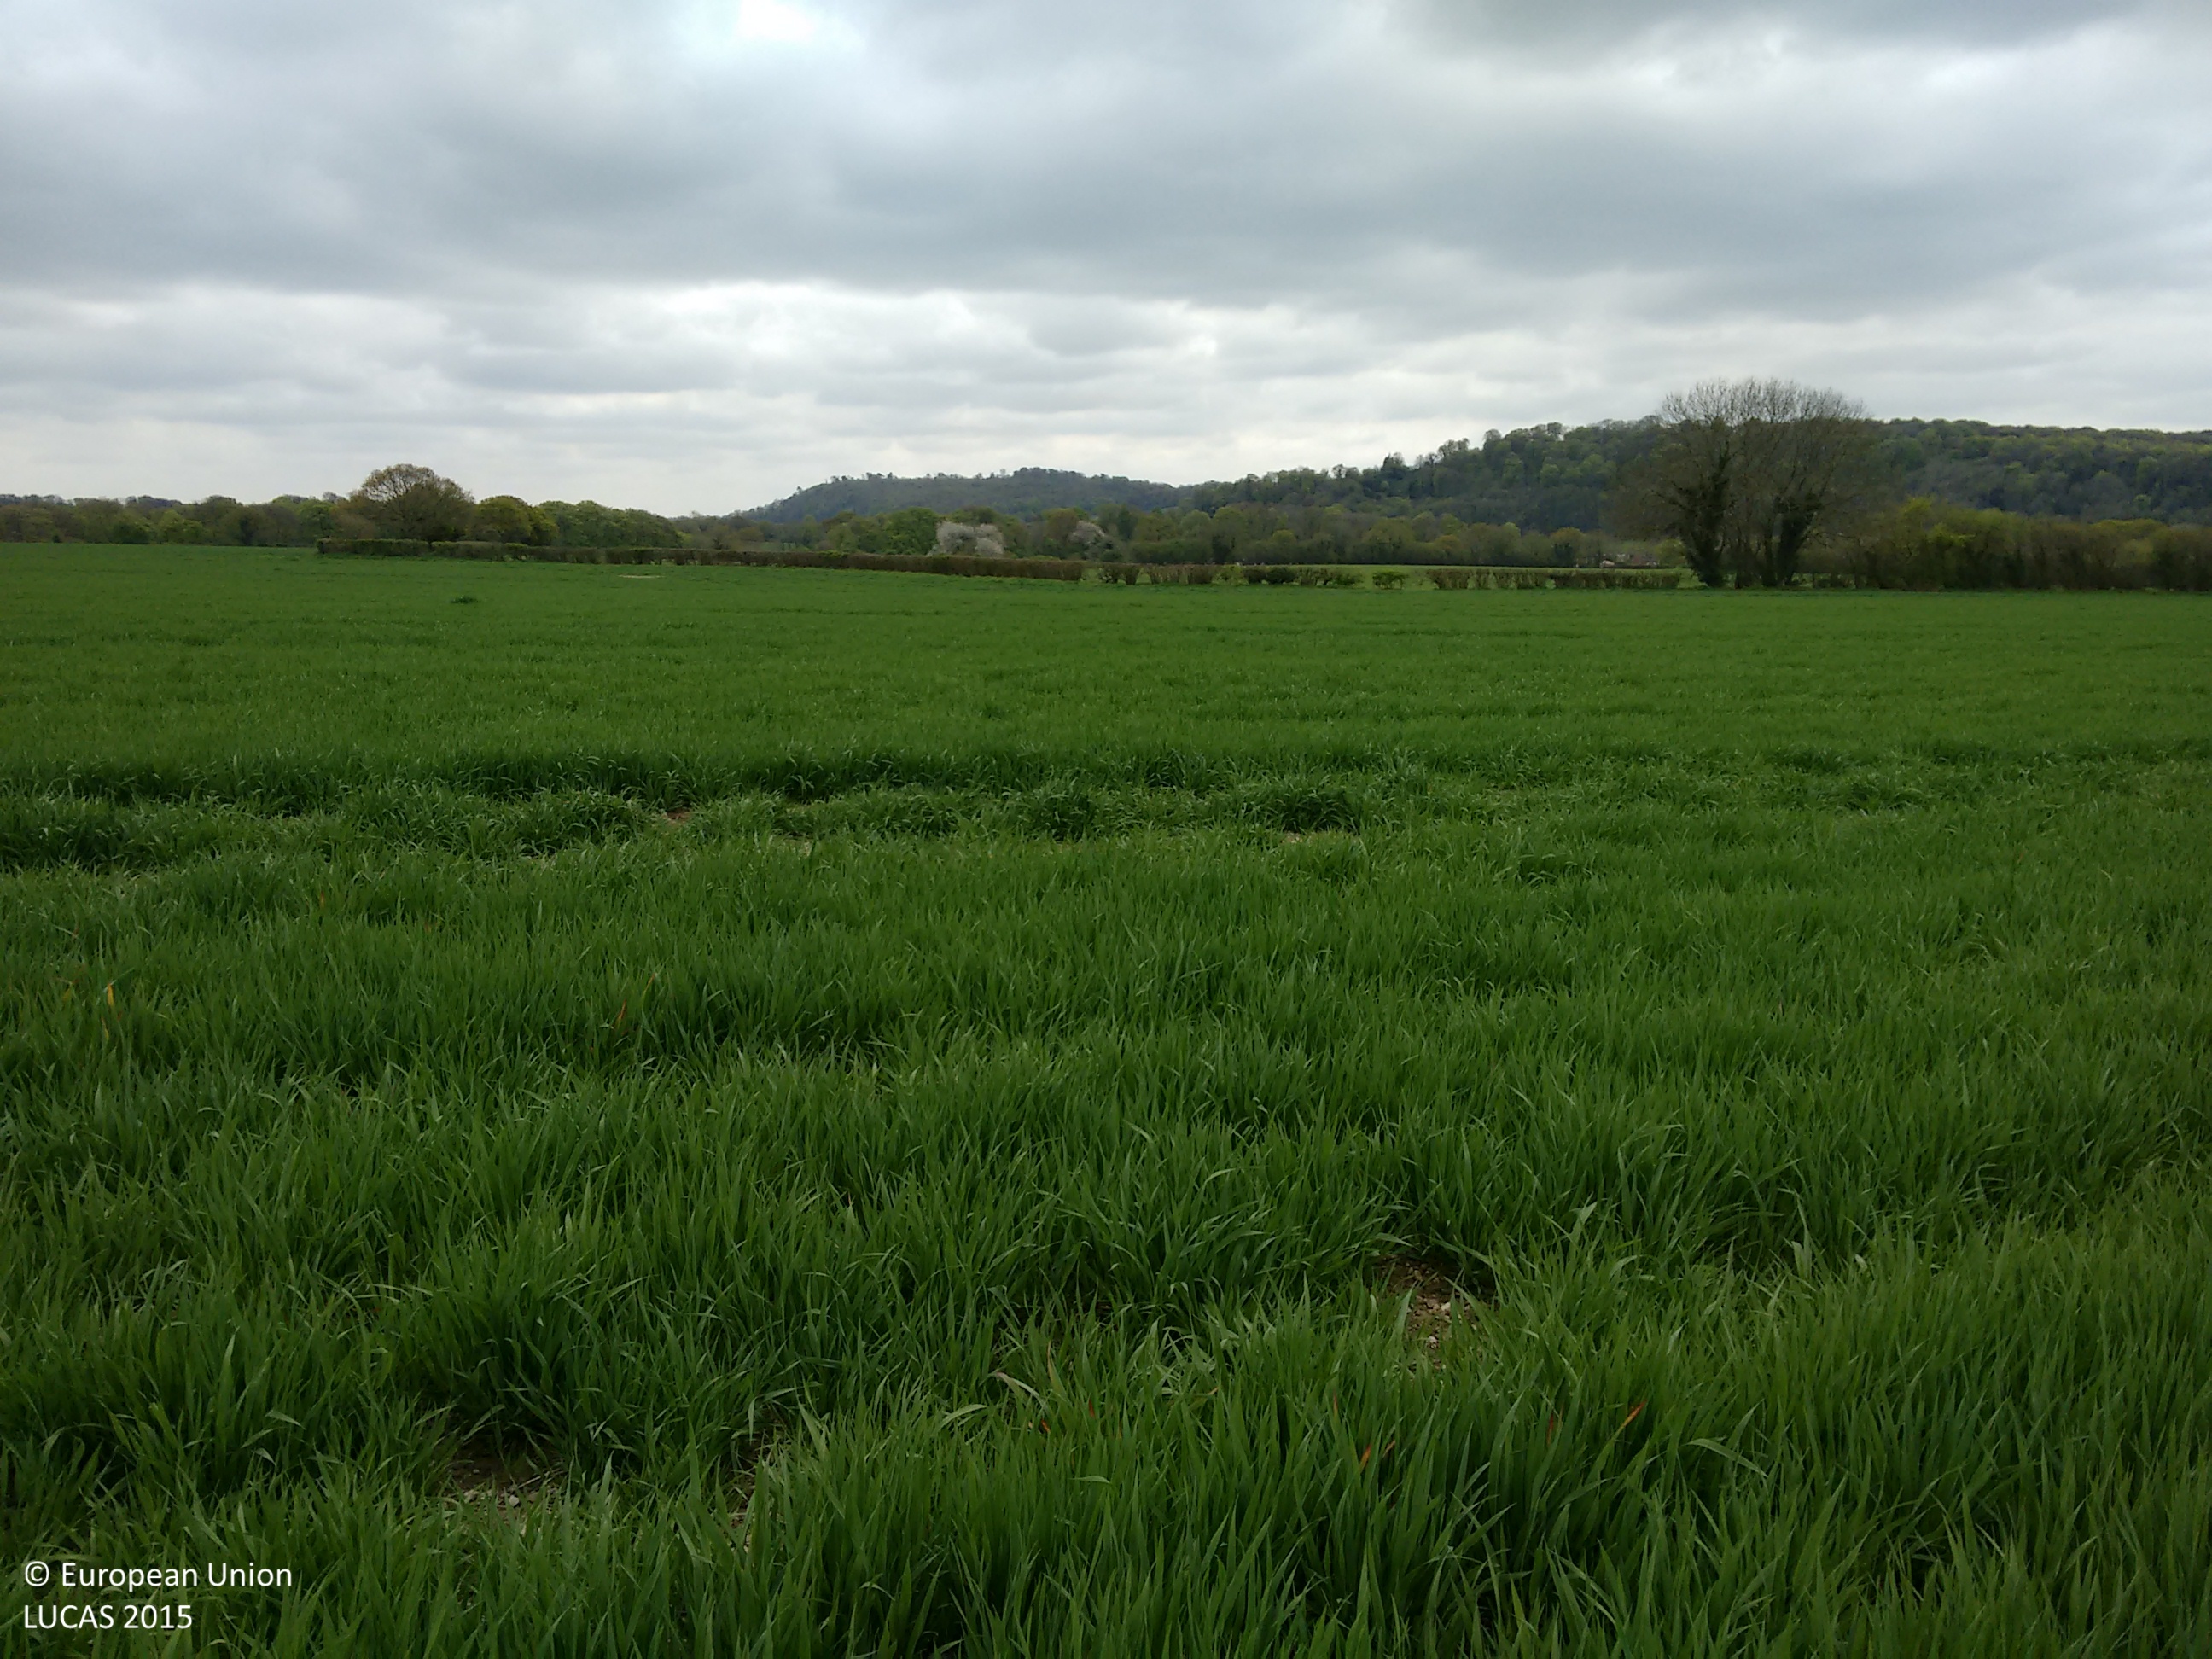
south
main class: Cropland
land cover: Oats
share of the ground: > 75 %
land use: Agriculture (excluding fallow land and kitchen gardens)
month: May
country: GB
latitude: 51.1078
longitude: -0.9416
